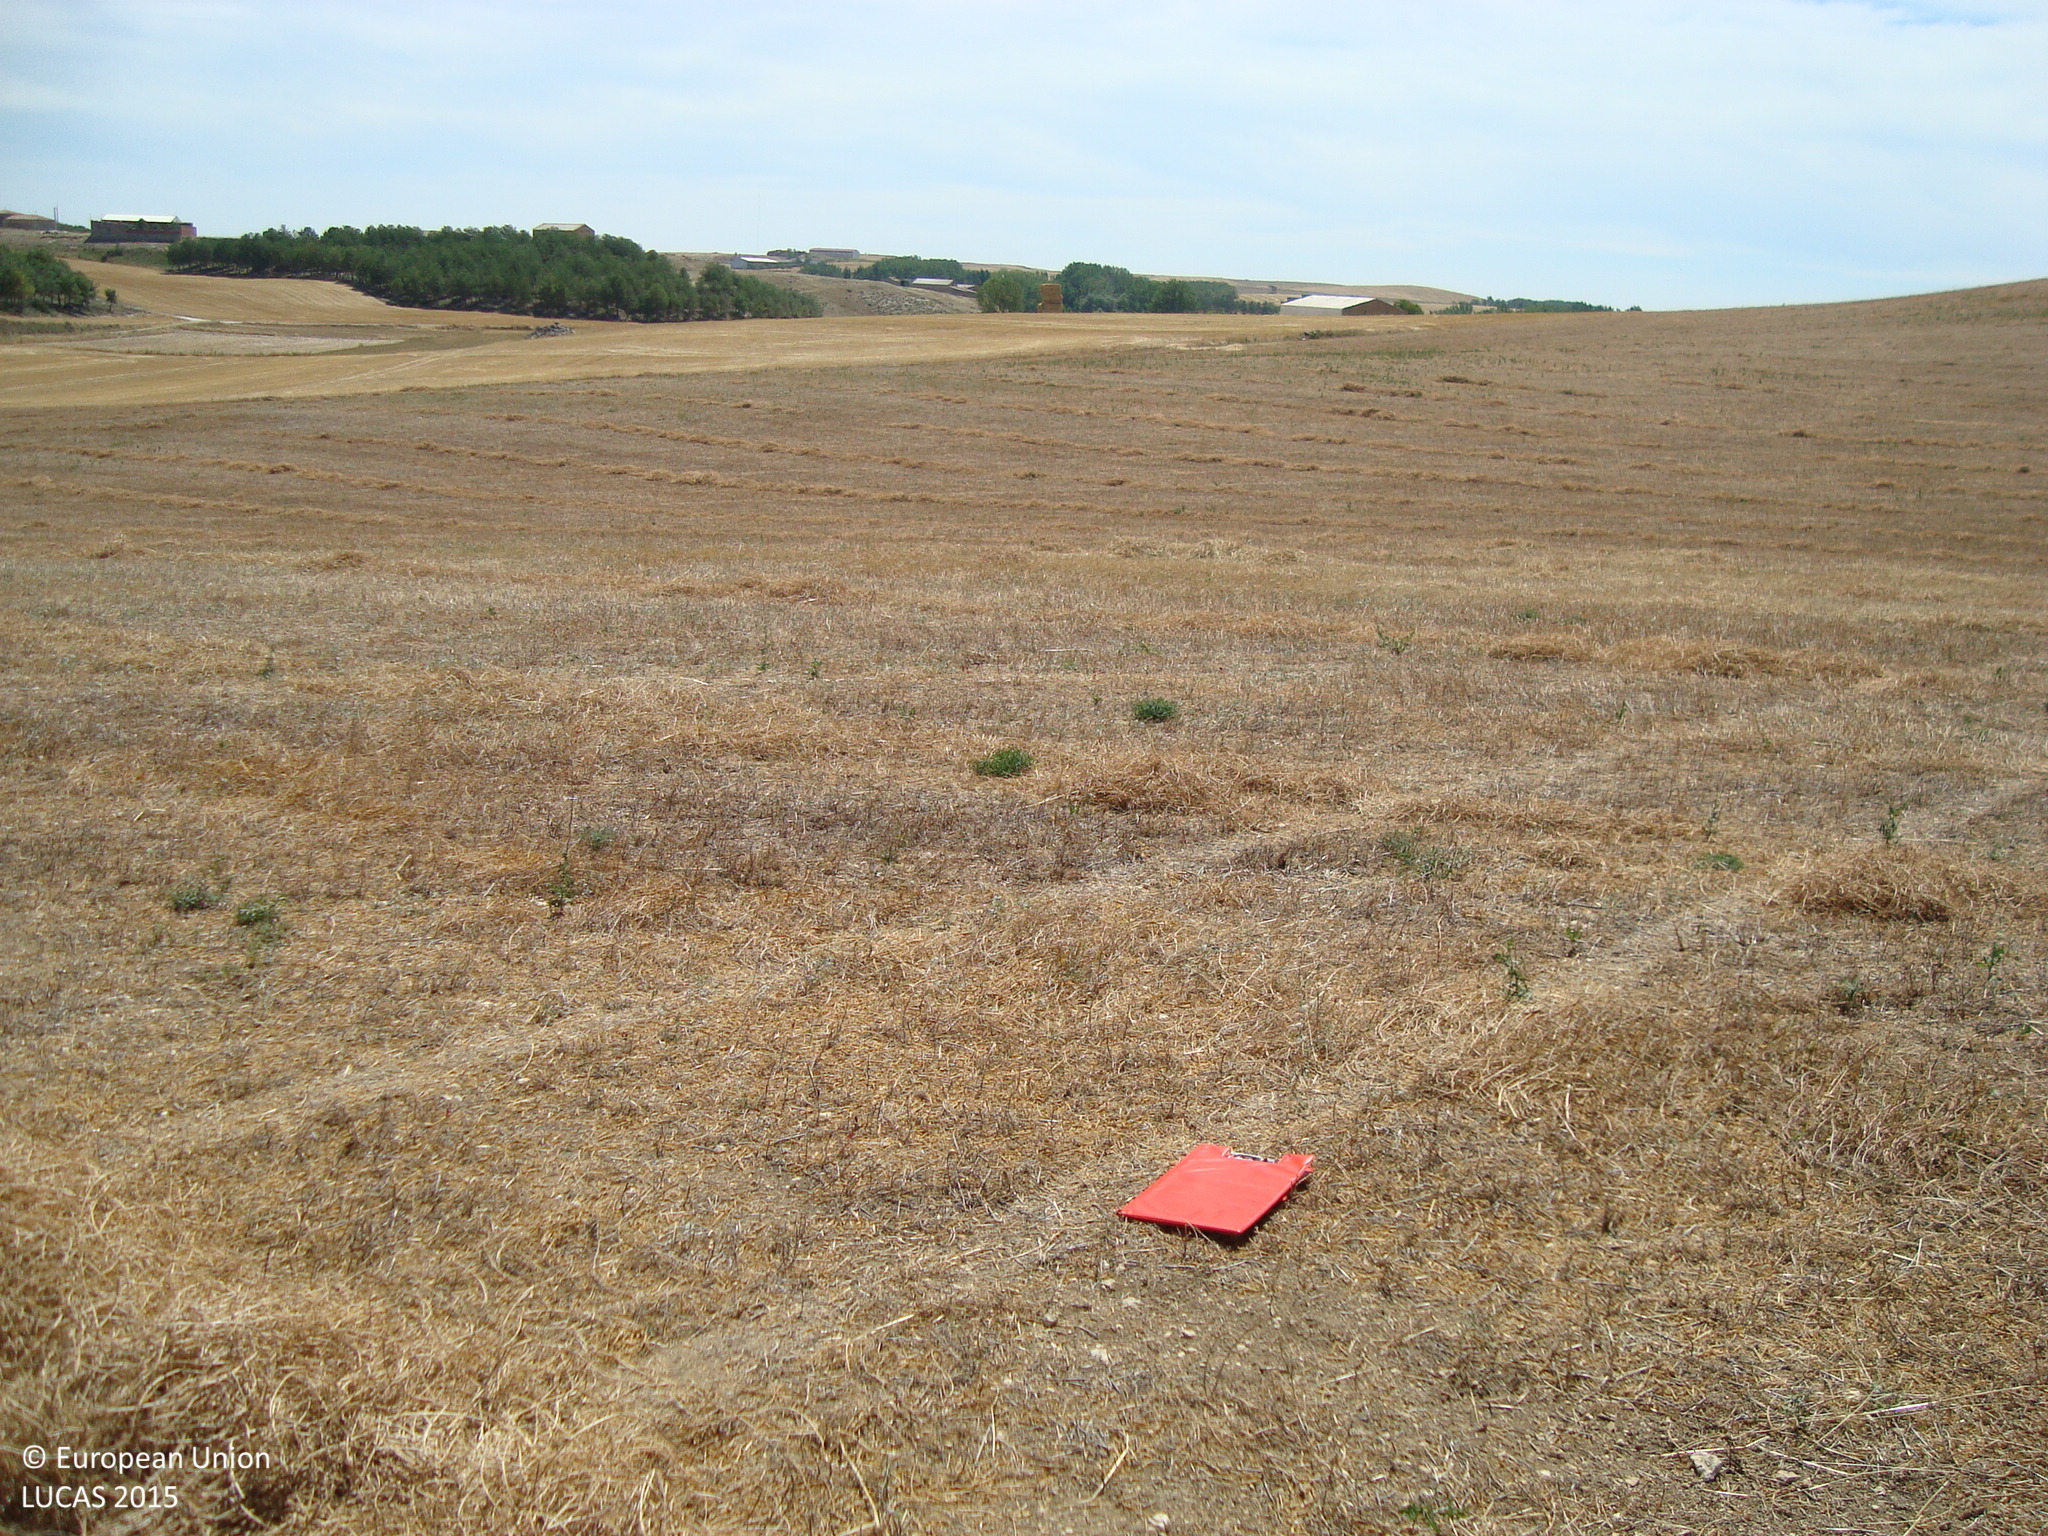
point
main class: Cropland
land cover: Dry pulses
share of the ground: > 75 %
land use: Agriculture (excluding fallow land and kitchen gardens)
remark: Harvested field
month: July
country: ES
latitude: 41.8862
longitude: -3.8076
